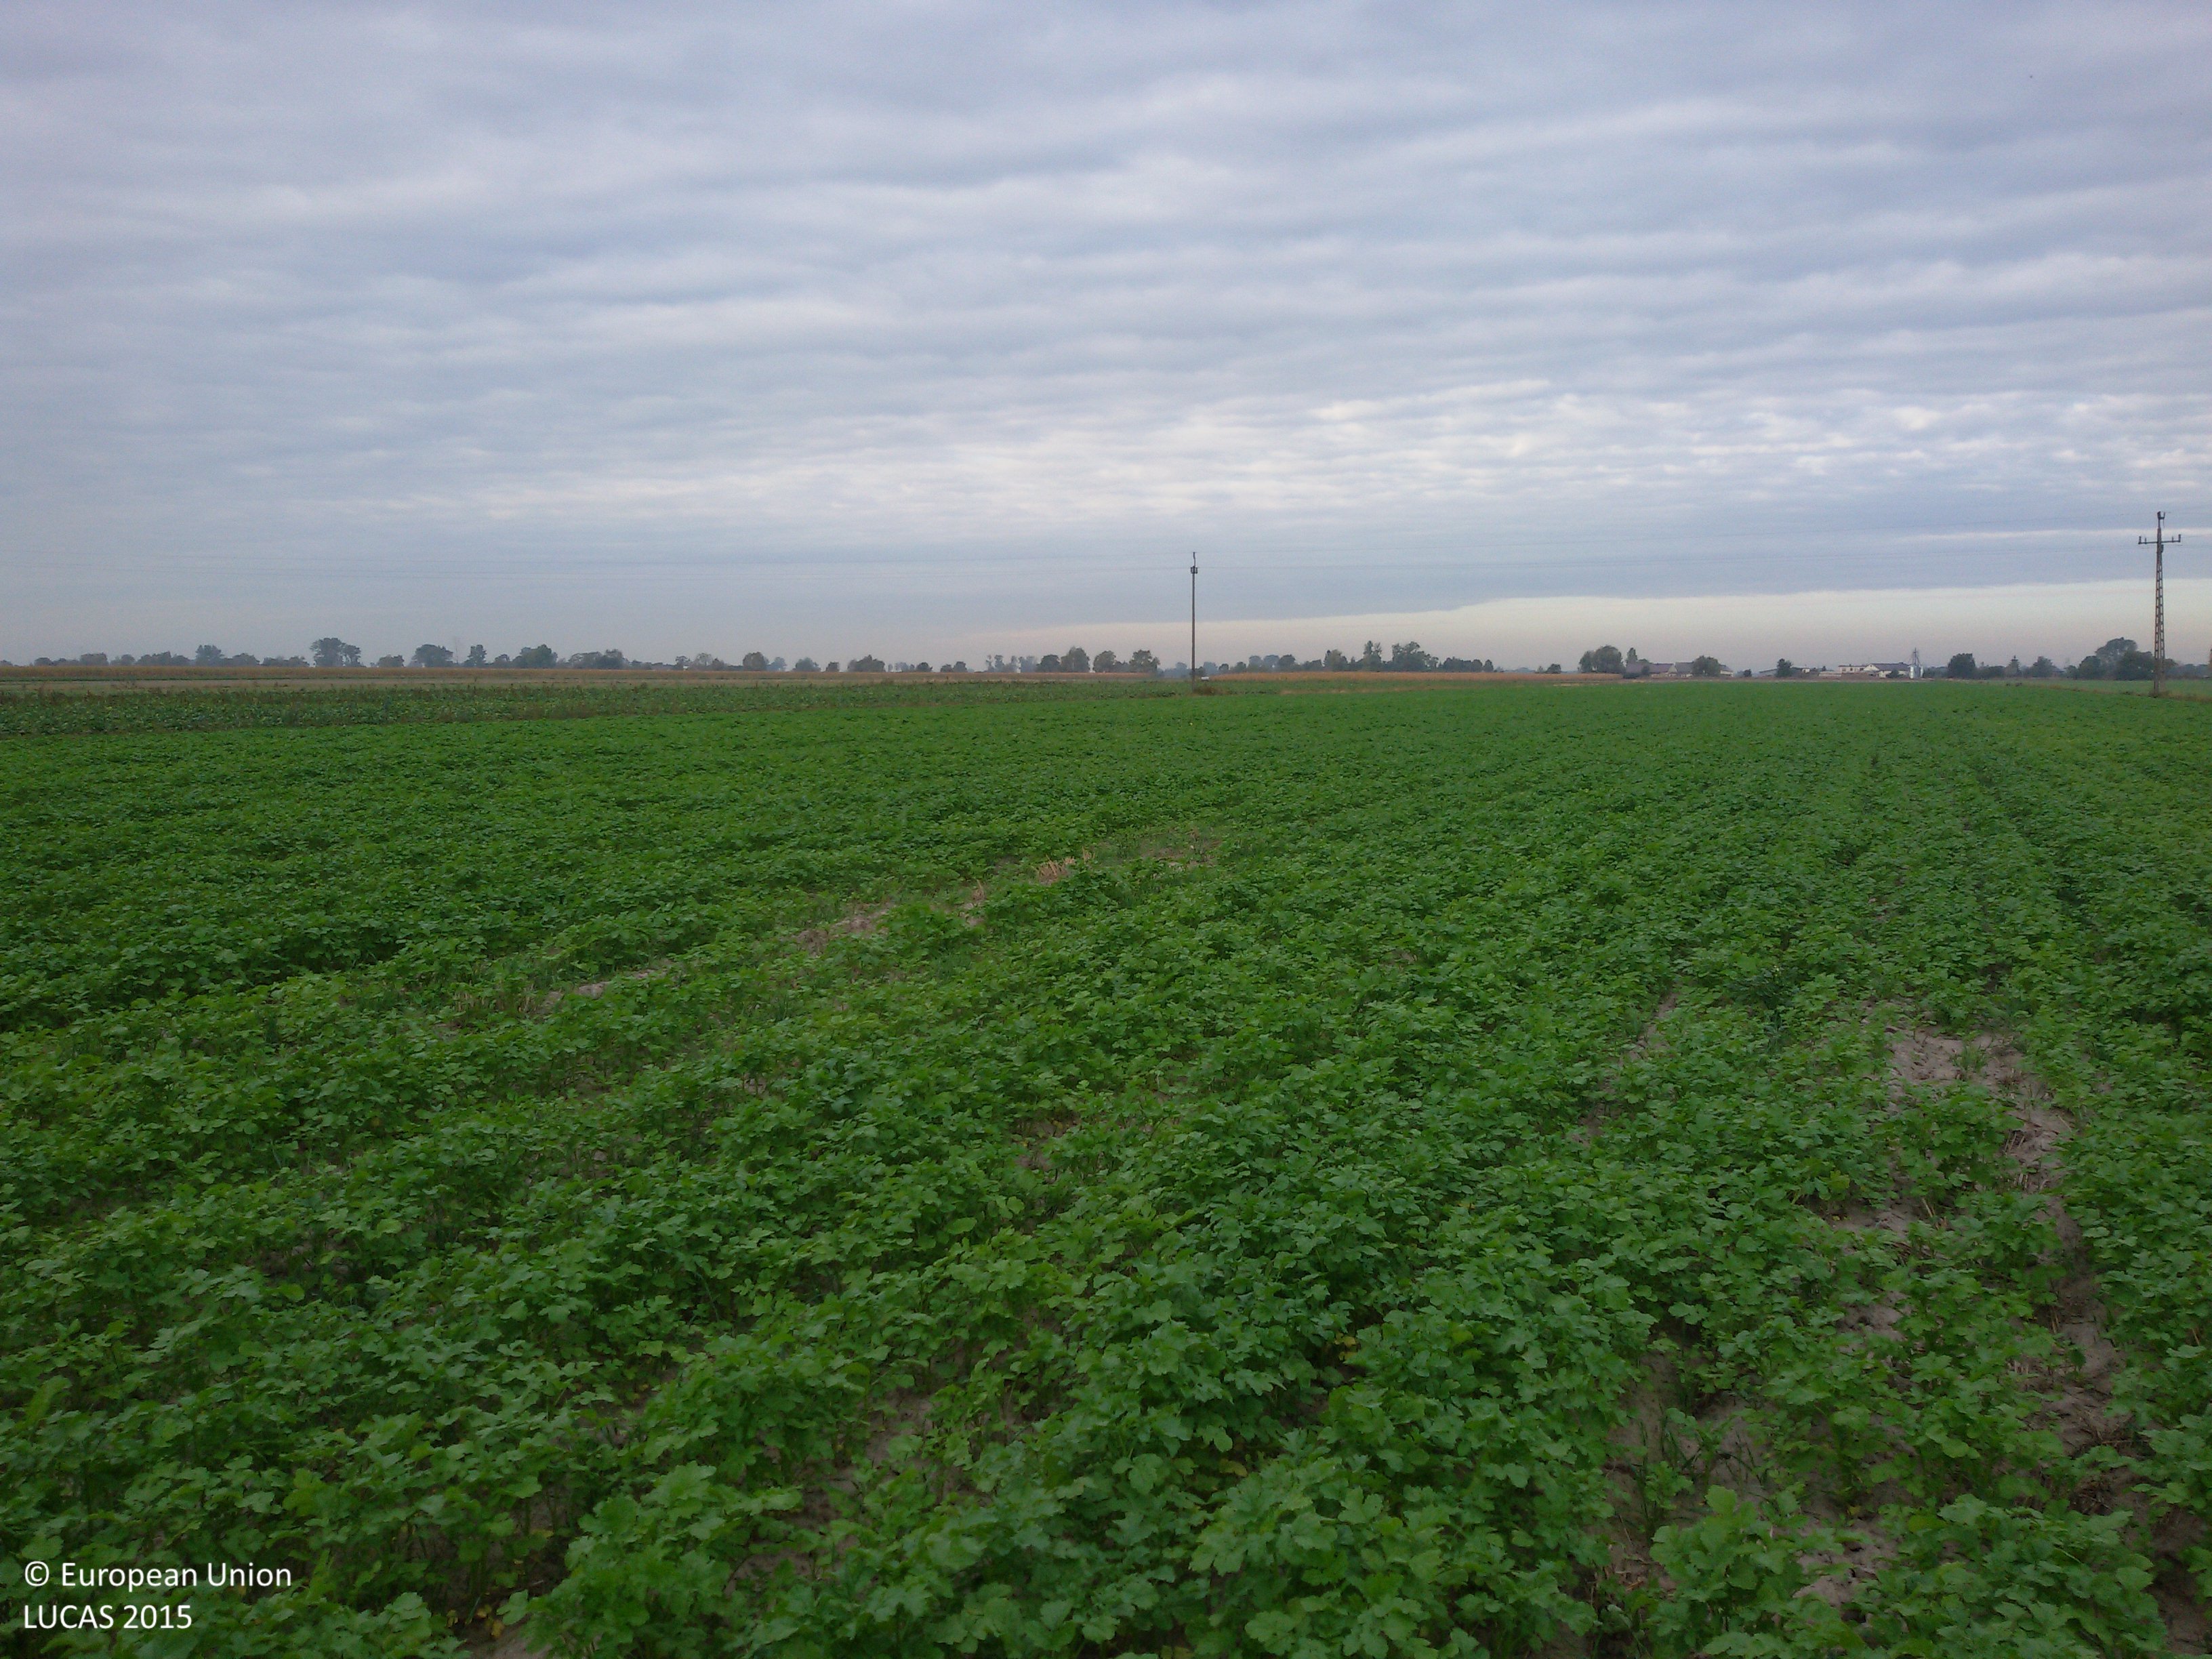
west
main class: Cropland
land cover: Rape and turnip rape
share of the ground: > 75 %
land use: Agriculture (excluding fallow land and kitchen gardens)
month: September
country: PL
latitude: 52.2895
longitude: 17.9763
